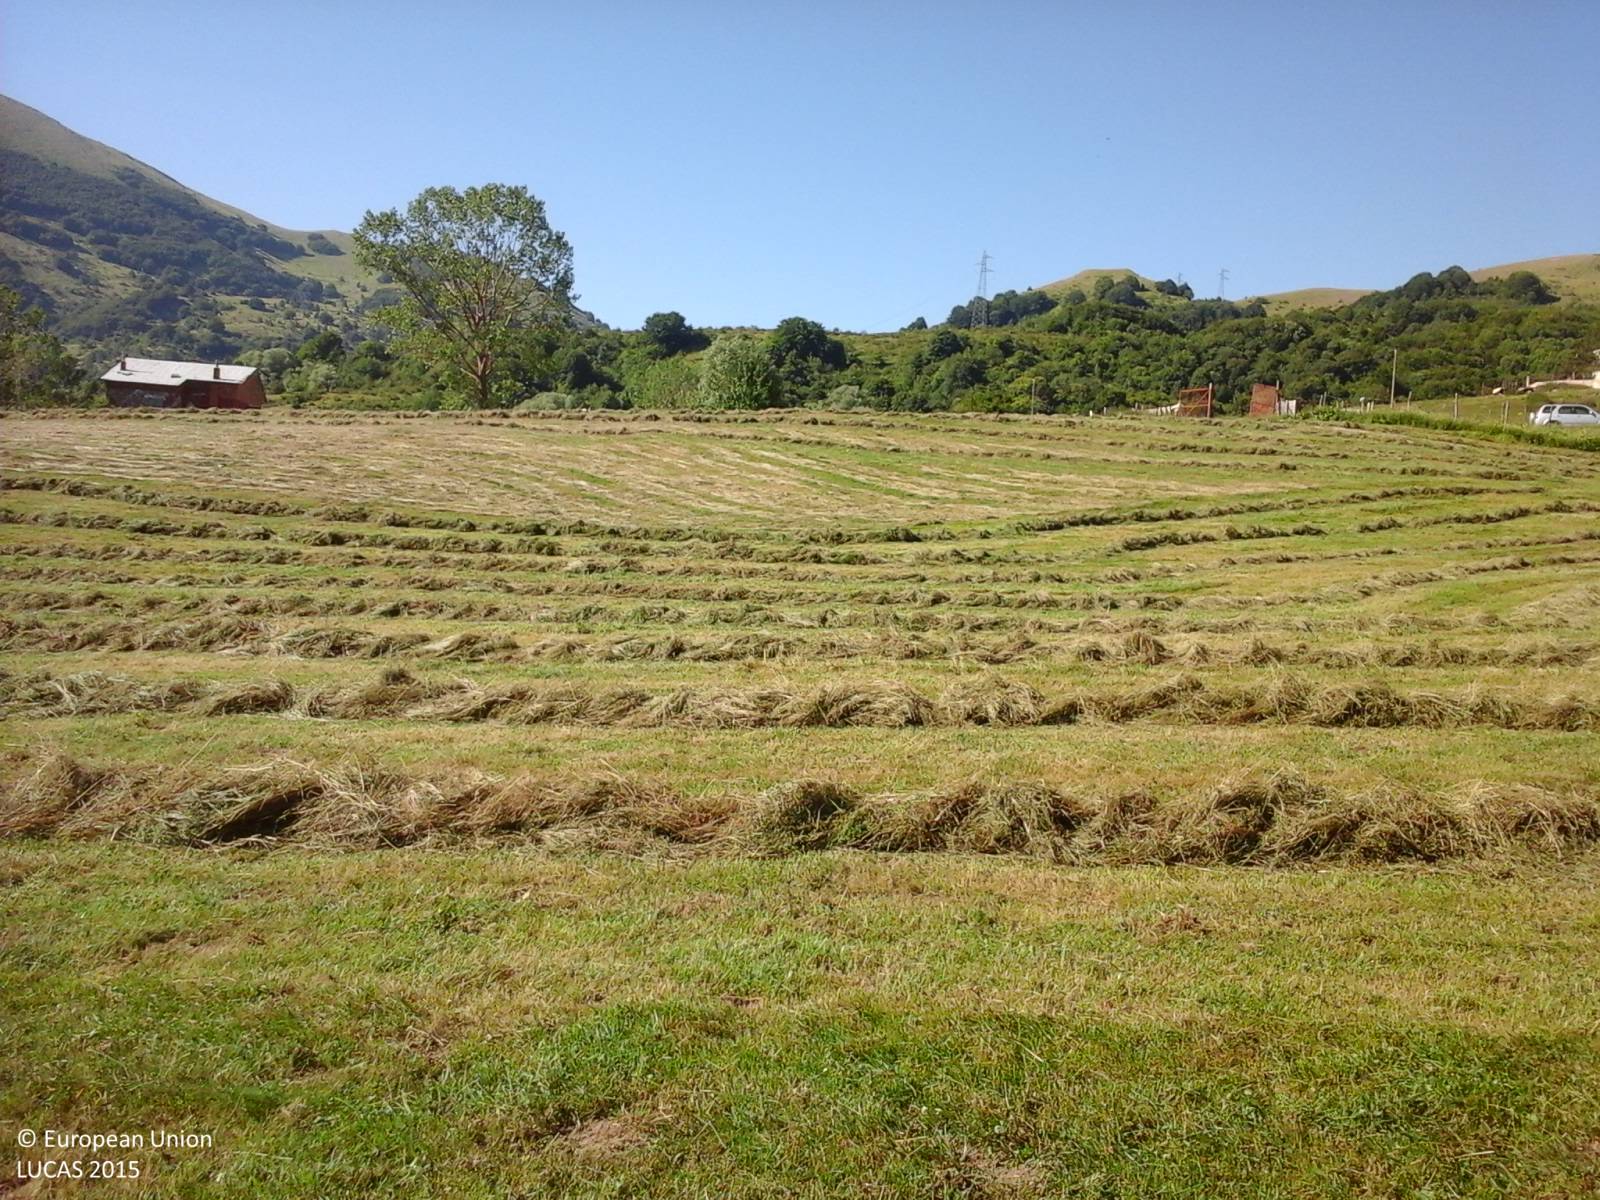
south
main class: Shrubland
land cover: Shrubland without tree cover
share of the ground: > 75 %
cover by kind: shrubs 100 %
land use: Semi-natural and natural areas not in use
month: July
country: IT
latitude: 42.4899
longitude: 13.3596
